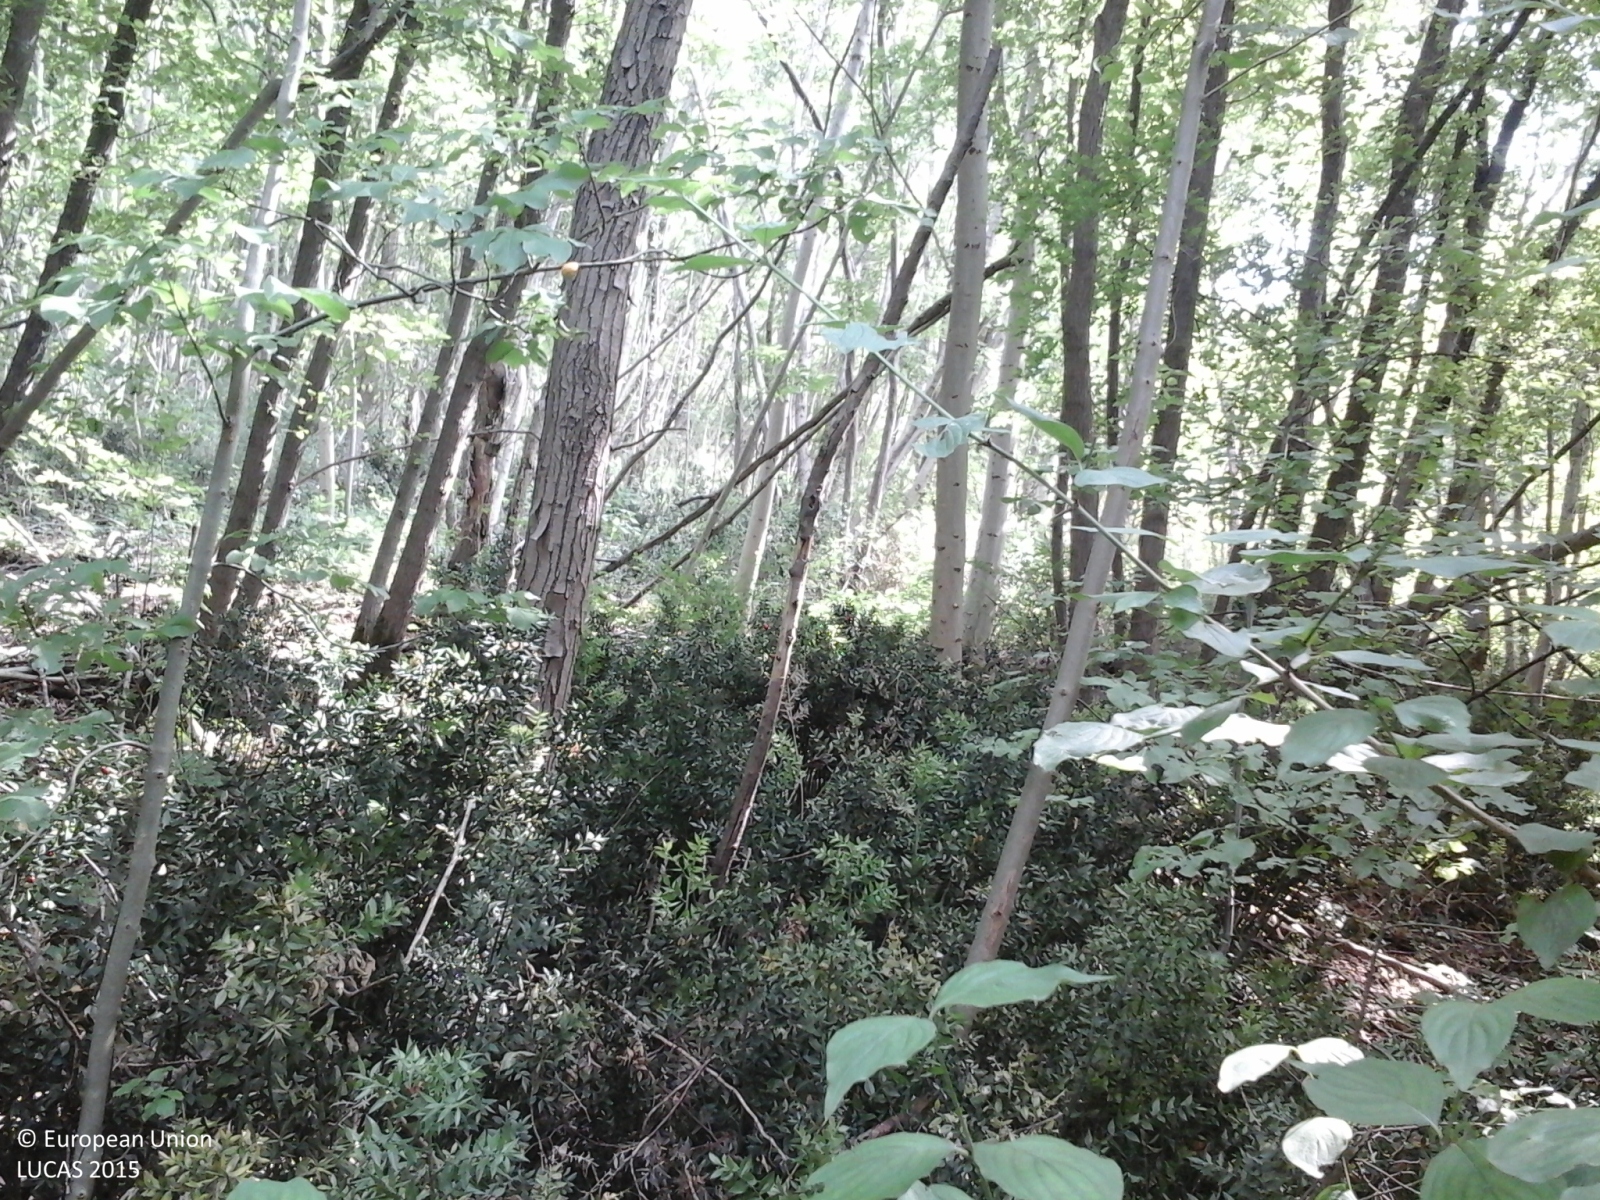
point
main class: Woodland
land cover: Broadleaved woodland
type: thermophilous deciduous forest
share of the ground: > 75 %
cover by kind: broadleaved forest trees 100 %
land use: Semi-natural and natural areas not in use
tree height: > 5 m
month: June
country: IT
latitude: 45.2925
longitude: 11.6929
